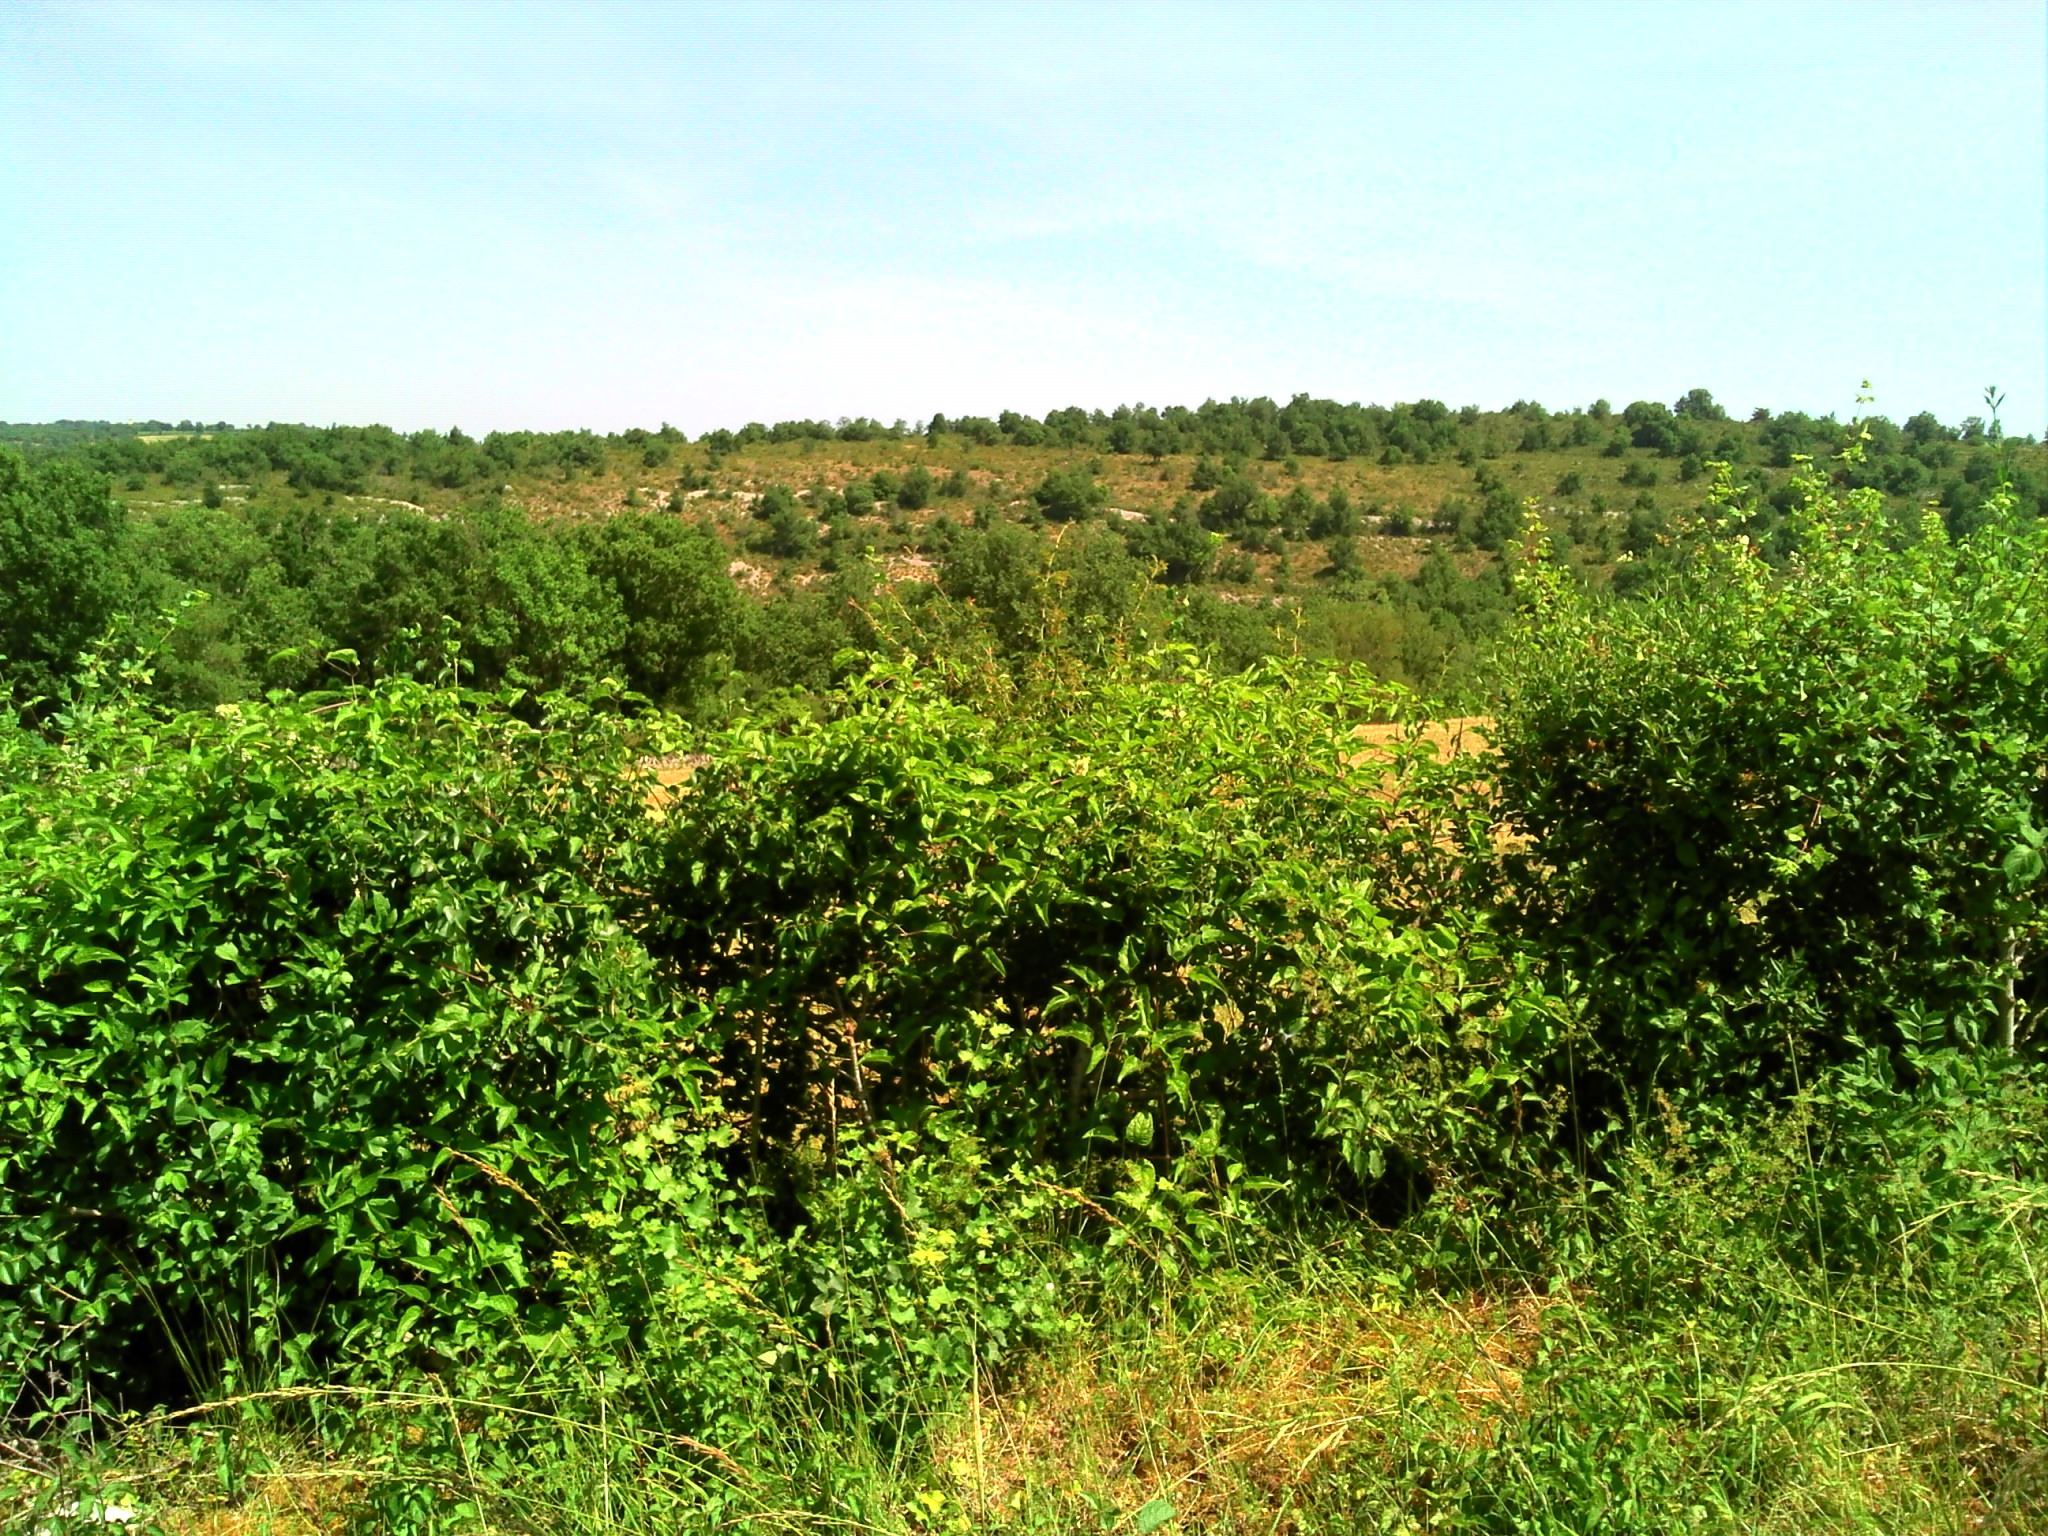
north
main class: Grassland
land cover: Grassland without tree/shrub cover
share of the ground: > 75 %
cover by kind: herbaceous plants 100 %
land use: Agriculture (excluding fallow land and kitchen gardens)
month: June
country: FR
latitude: 44.4977
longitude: 1.8124
